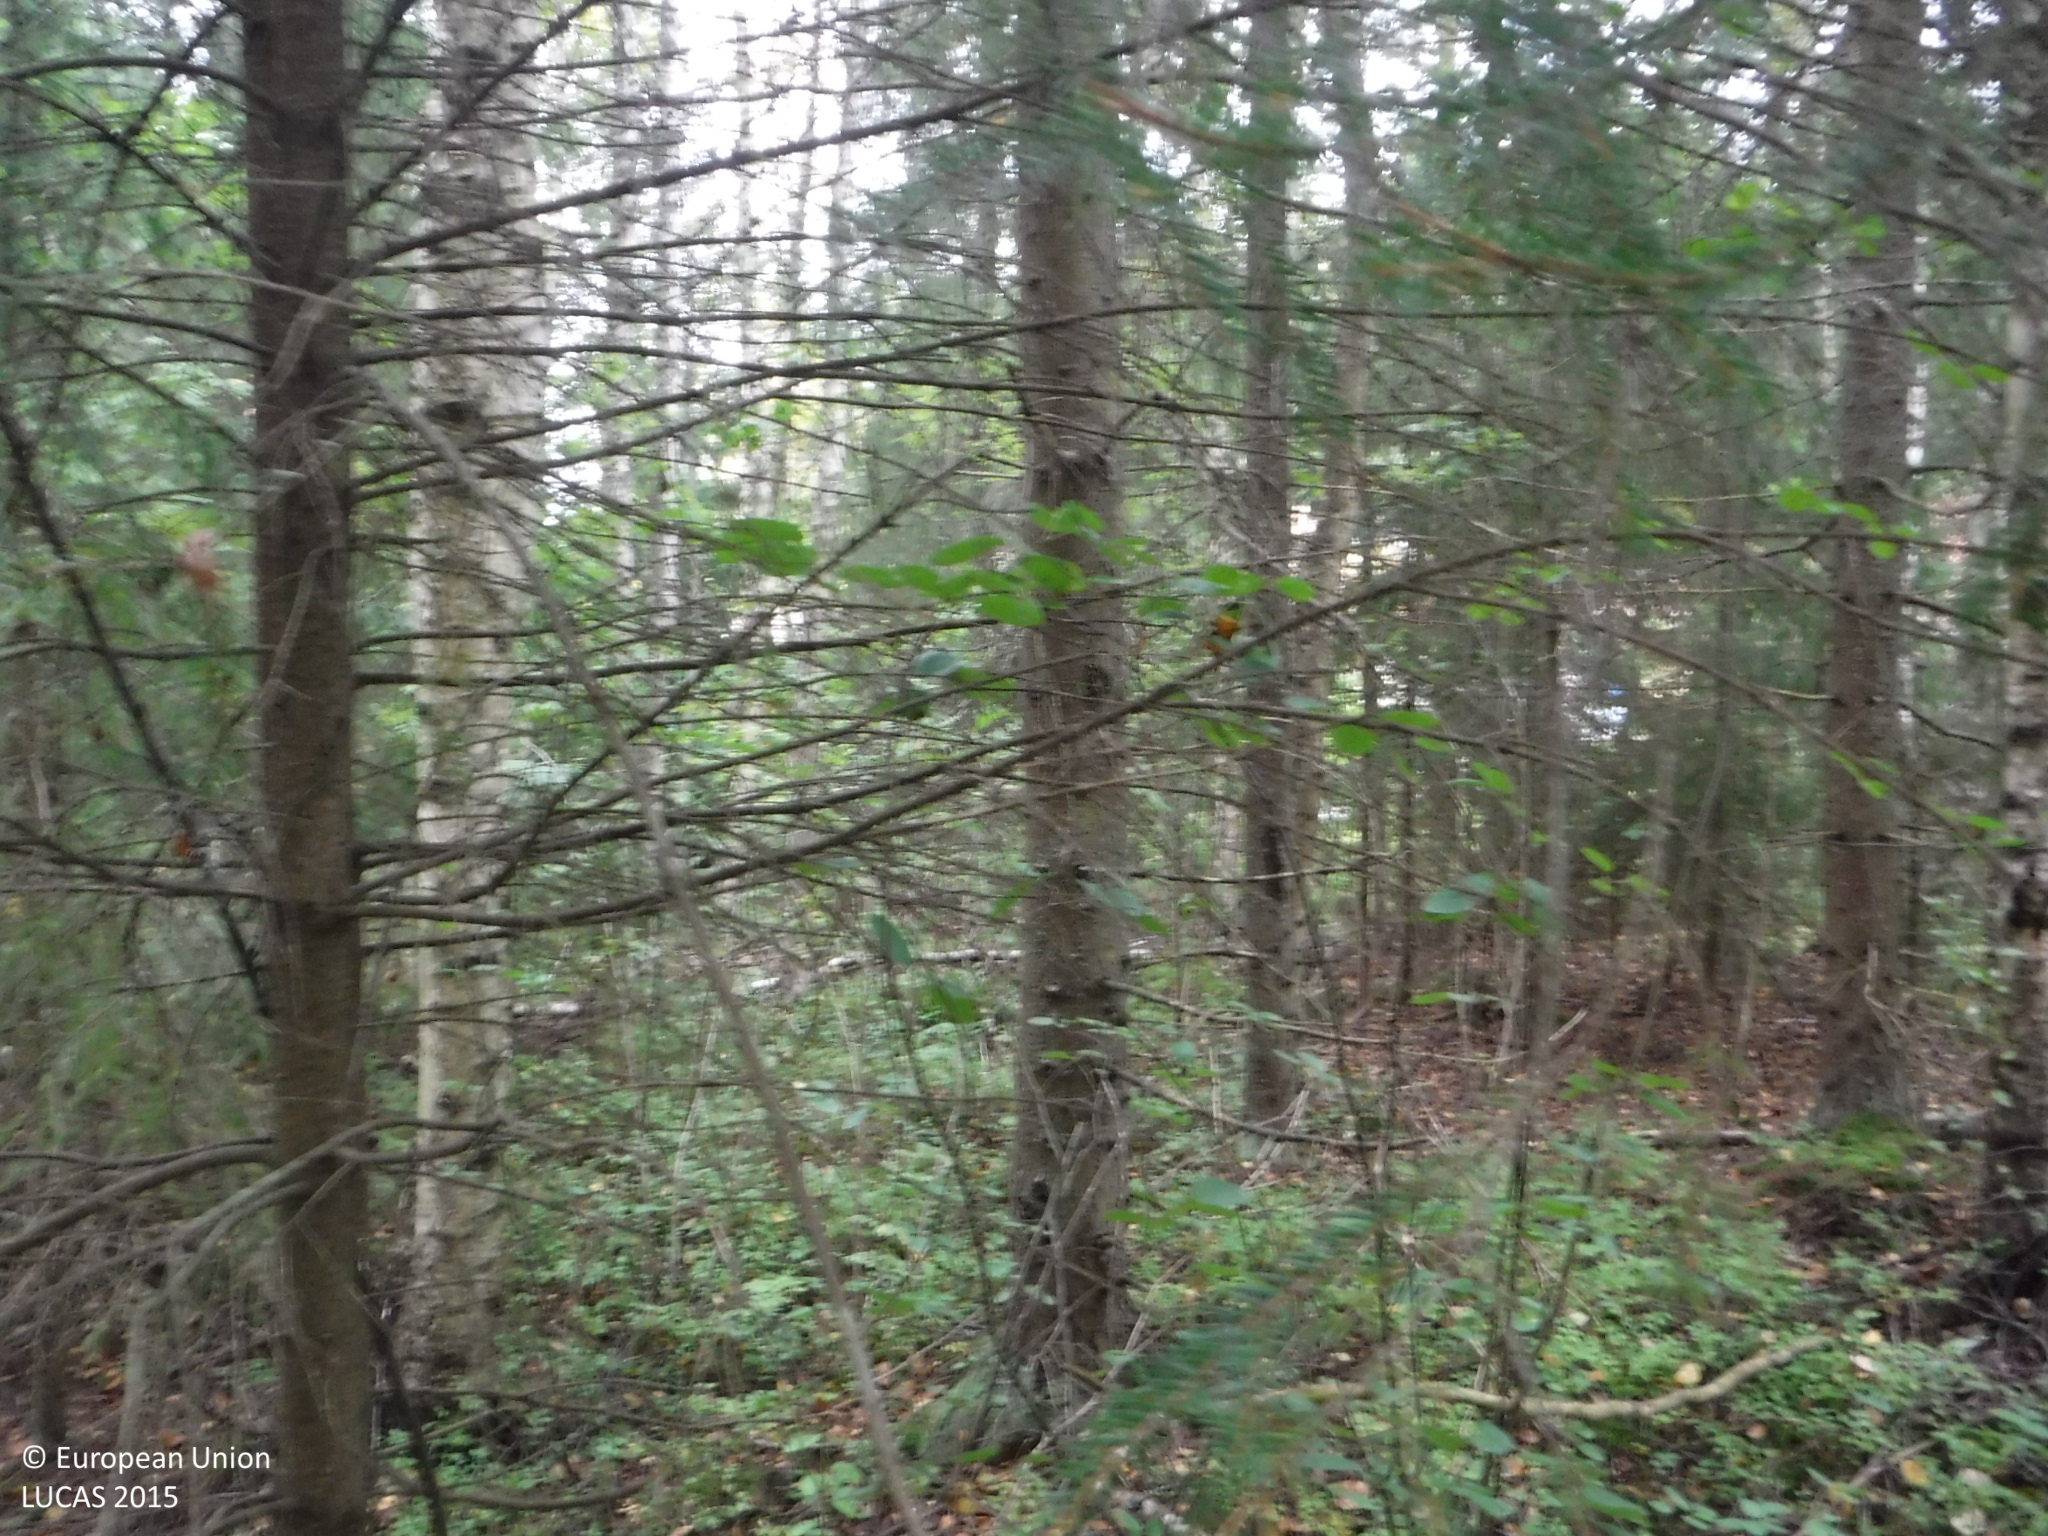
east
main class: Woodland
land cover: Spruce dominated mixed woodland
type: boreal forest
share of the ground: > 75 %
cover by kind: coniferous forest trees 45 %, broadleaved forest trees 30 %, shrubs 20 %, lichens and mosses 5 %
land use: Forestry
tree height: > 5 m
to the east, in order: Spruce dominated mixed woodland; Artificial constructions in urban areas; Ditches and canals; Groves; Spruce dominated coniferous woodland; Spruce dominated mixed woodland; Broadleaved woodland; Spontaneously vegetated surfaces; Broadleaved woodland; Artificial constructions in urban areas
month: September
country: FI
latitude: 61.3573
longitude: 22.9185
